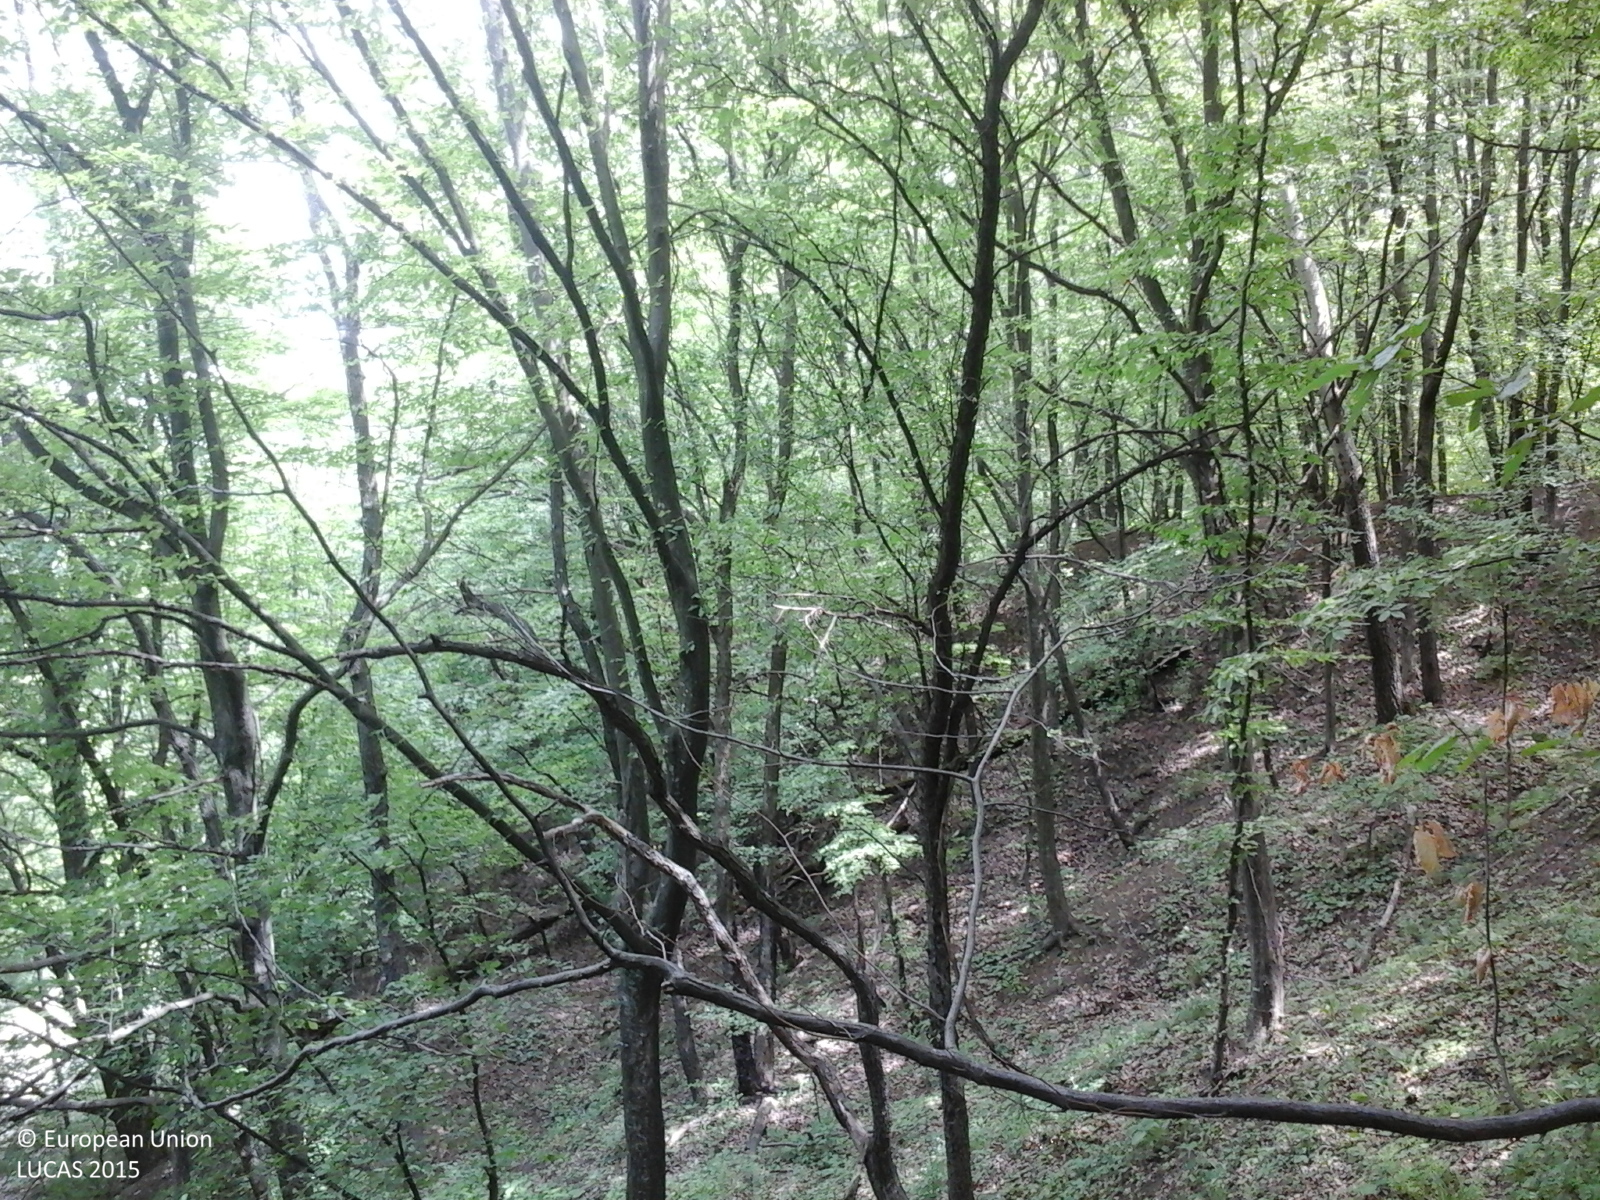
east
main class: Woodland
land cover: Broadleaved woodland
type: beech forest
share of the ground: > 75 %
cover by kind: broadleaved forest trees 95 %, herbaceous plants 5 %
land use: Forestry
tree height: > 5 m
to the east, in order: Broadleaved woodland; Ditches and canals; Broadleaved woodland; Ditches and canals; Broadleaved woodland
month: June
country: RO
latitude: 47.8932
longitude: 26.3377
